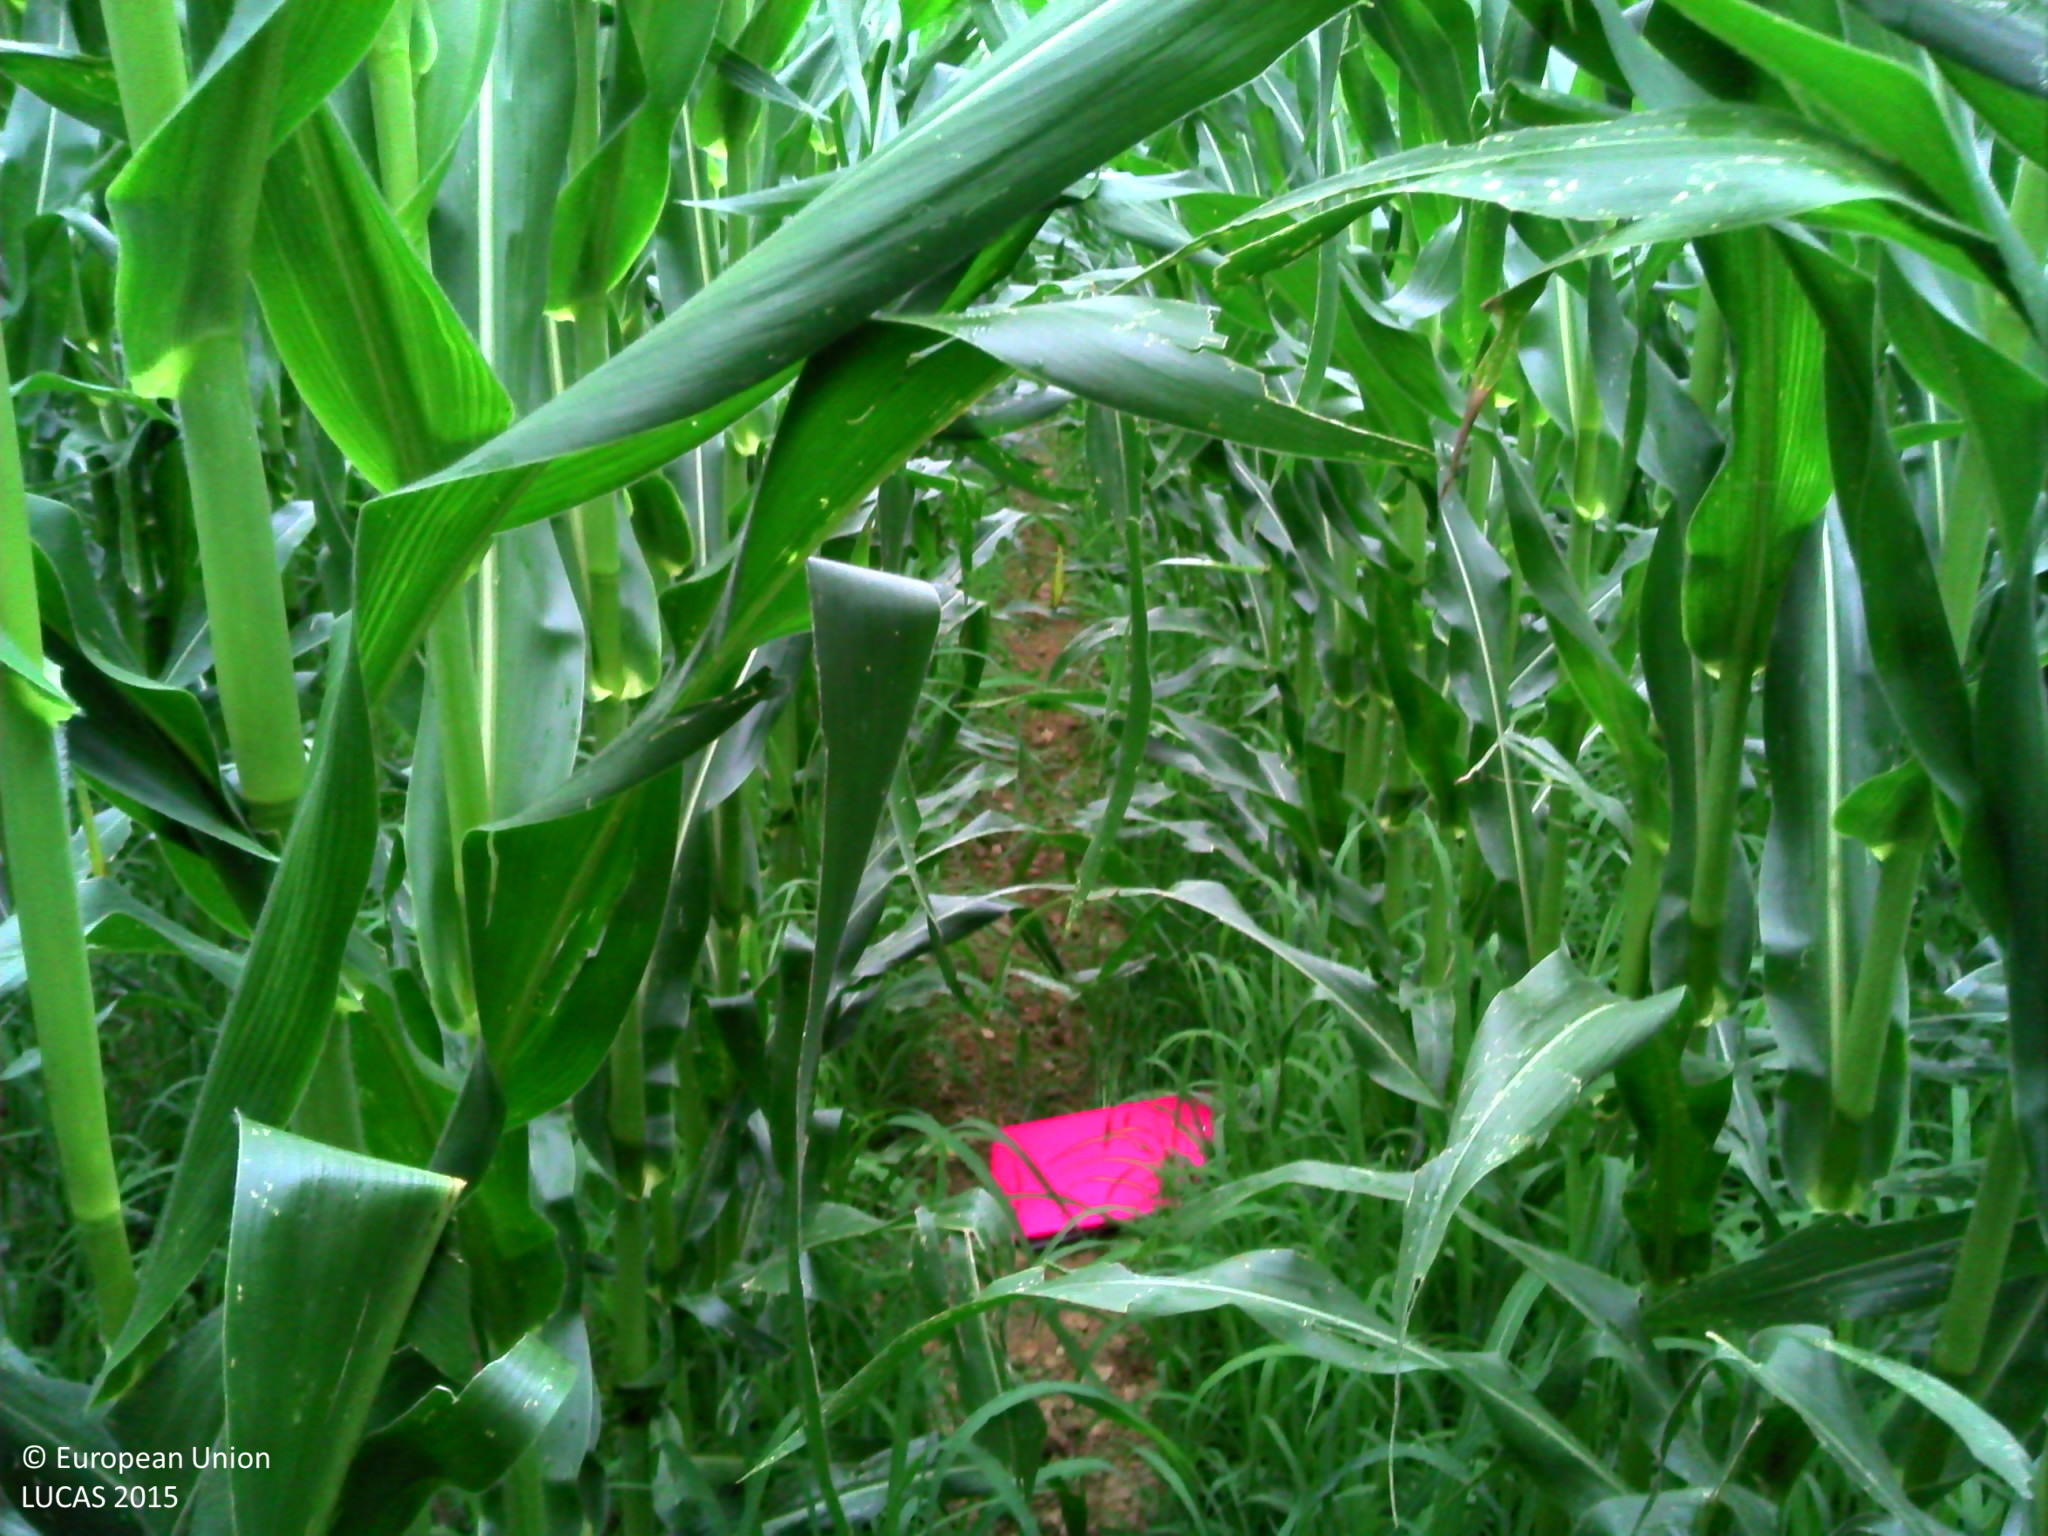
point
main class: Cropland
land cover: Maize
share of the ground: > 75 %
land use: Agriculture (excluding fallow land and kitchen gardens)
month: August
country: FR
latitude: 43.4307
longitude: -1.2197
